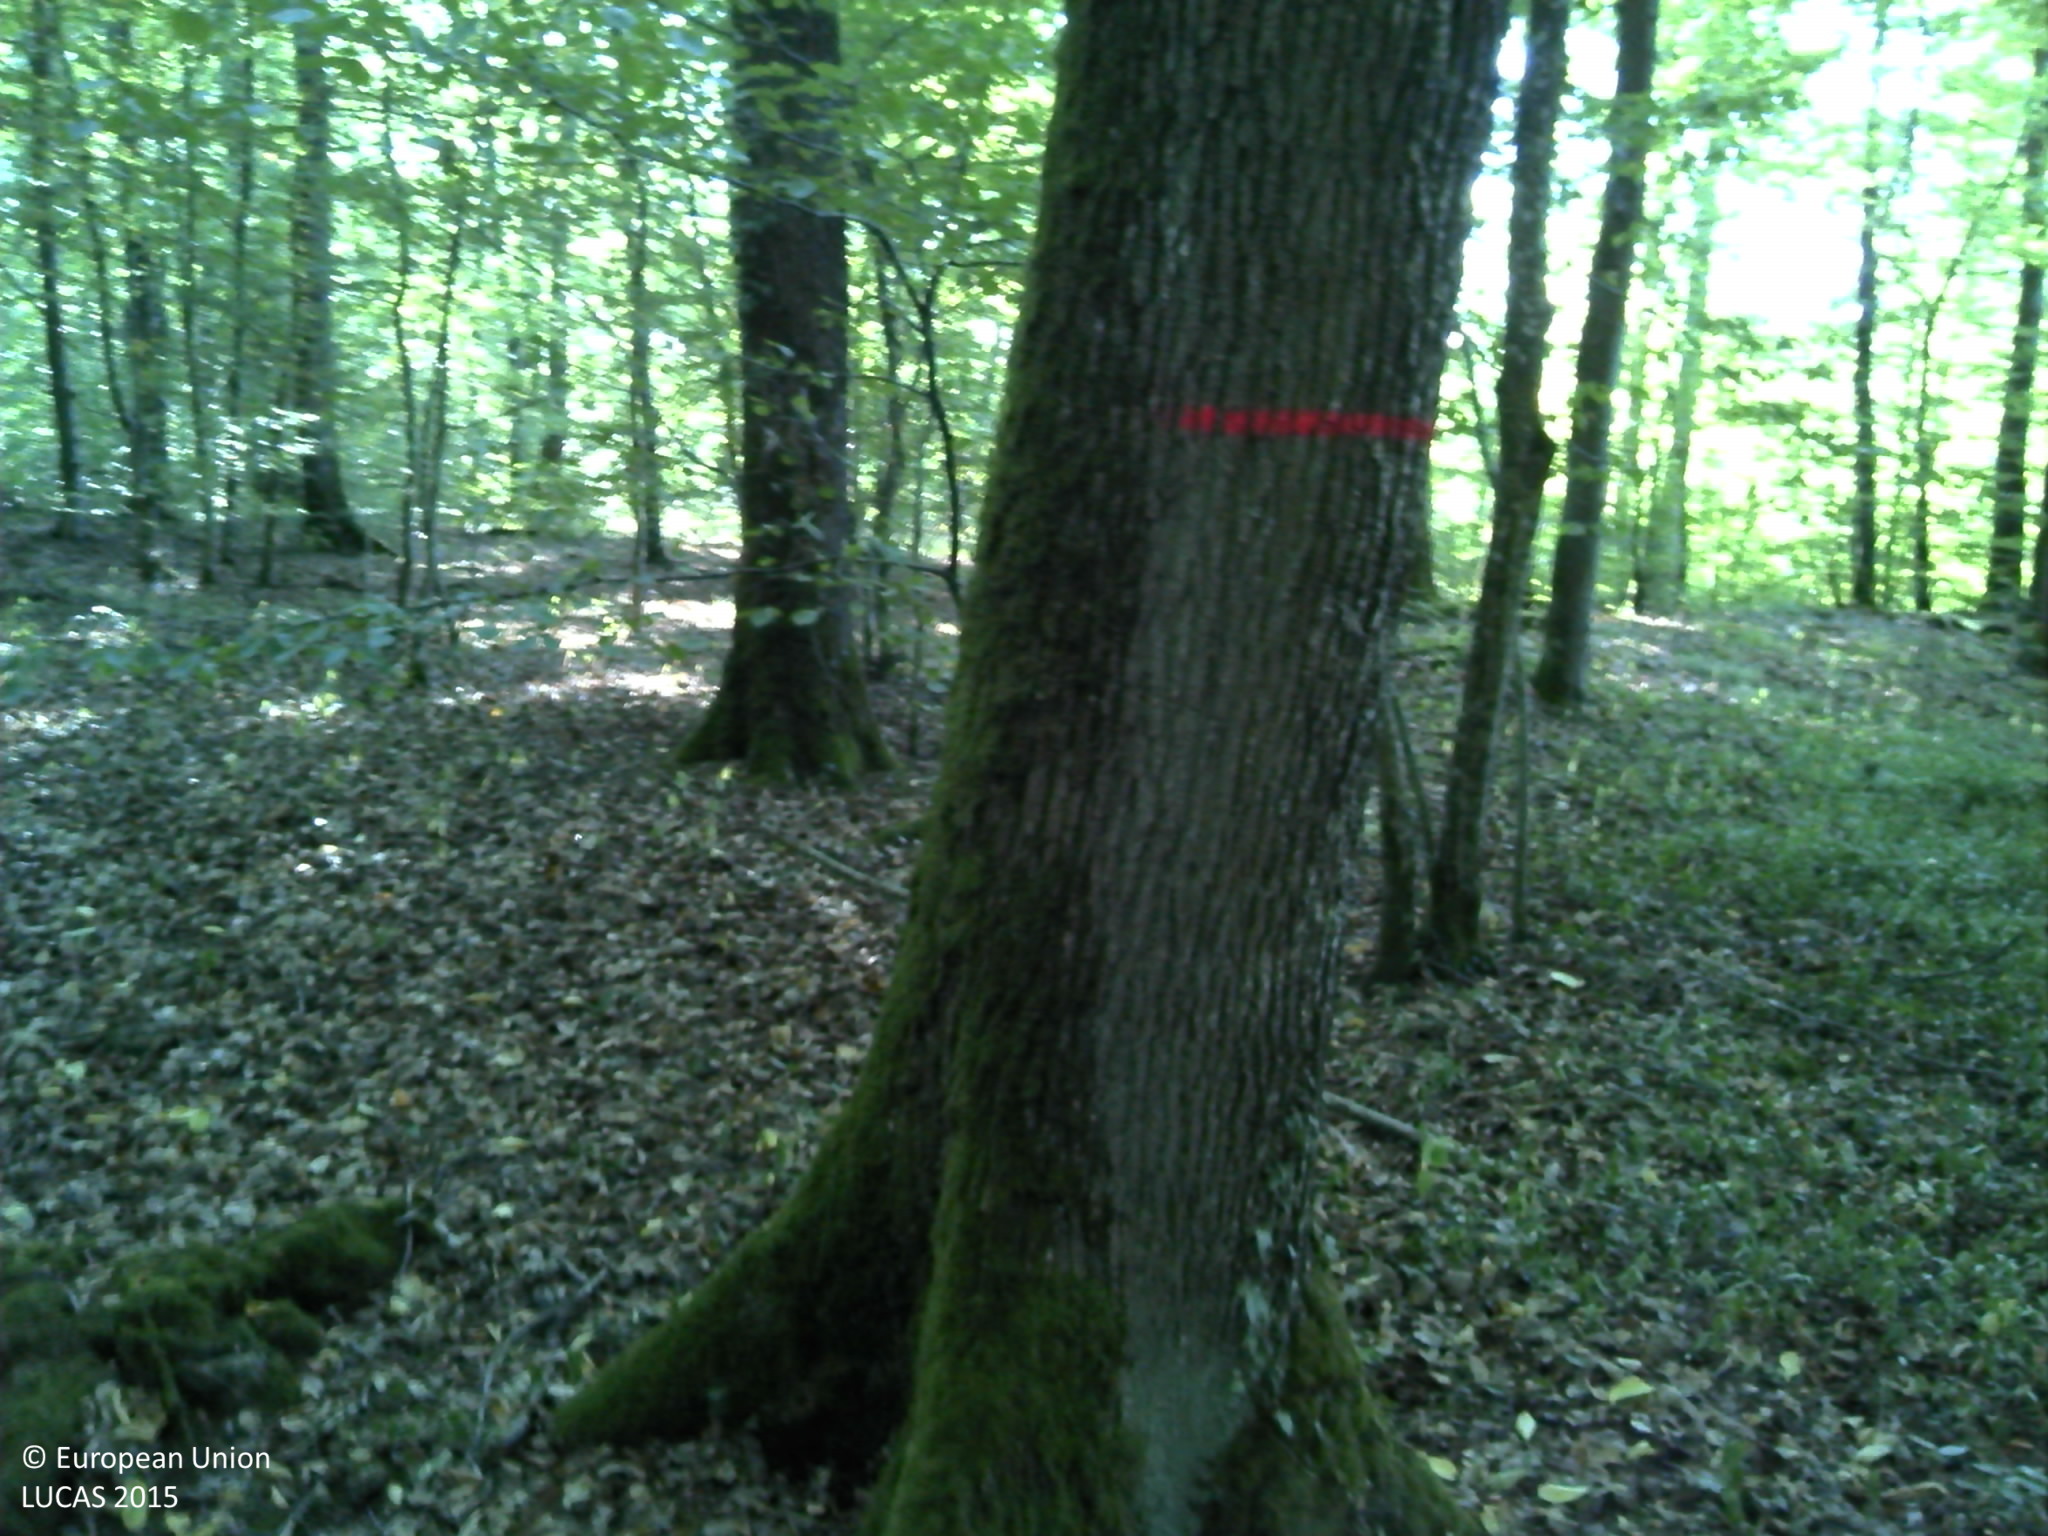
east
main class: Woodland
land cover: Broadleaved woodland
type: mountainous beech forest
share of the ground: > 75 %
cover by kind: broadleaved forest trees 100 %
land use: Forestry
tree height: > 5 m
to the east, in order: Broadleaved woodland; Tracks; Broadleaved woodland; Tracks; Broadleaved woodland
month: July
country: FR
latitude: 48.2970
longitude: 6.0506
